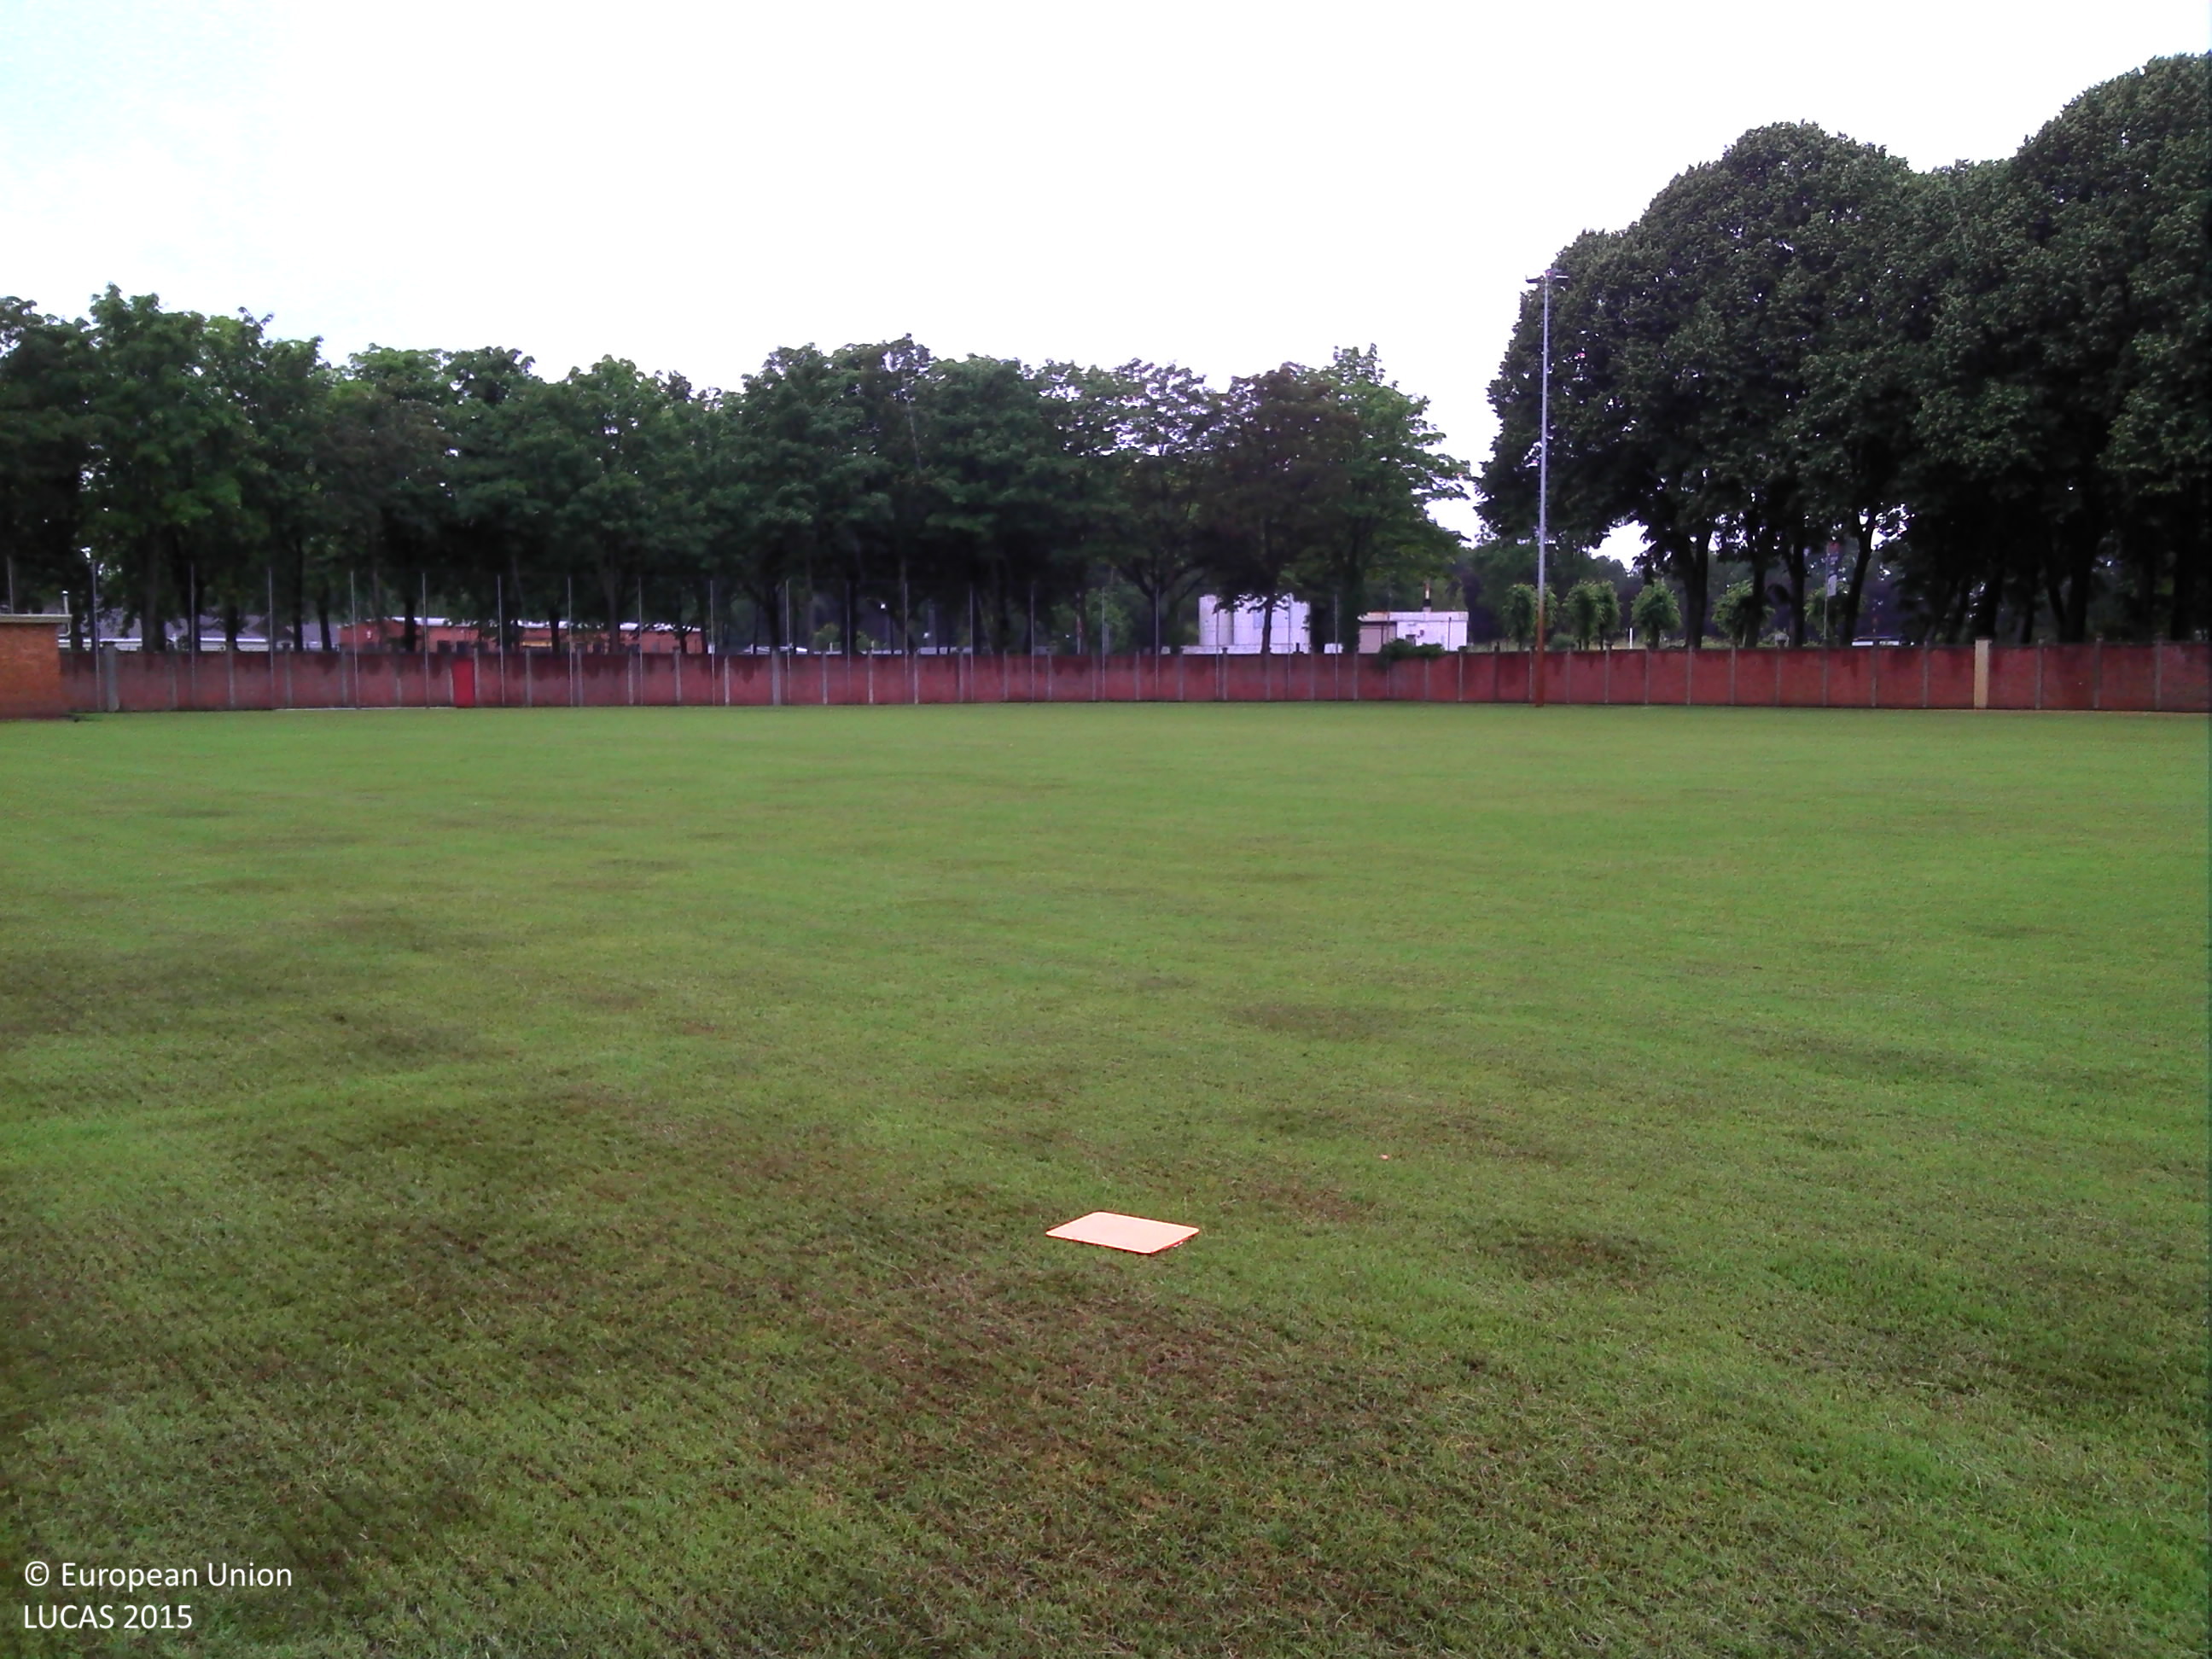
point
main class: Grassland
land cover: Grassland without tree/shrub cover
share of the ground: > 75 %
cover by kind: herbaceous plants 100 %
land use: Sport
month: June
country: BE
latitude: 51.0746
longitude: 5.2162
